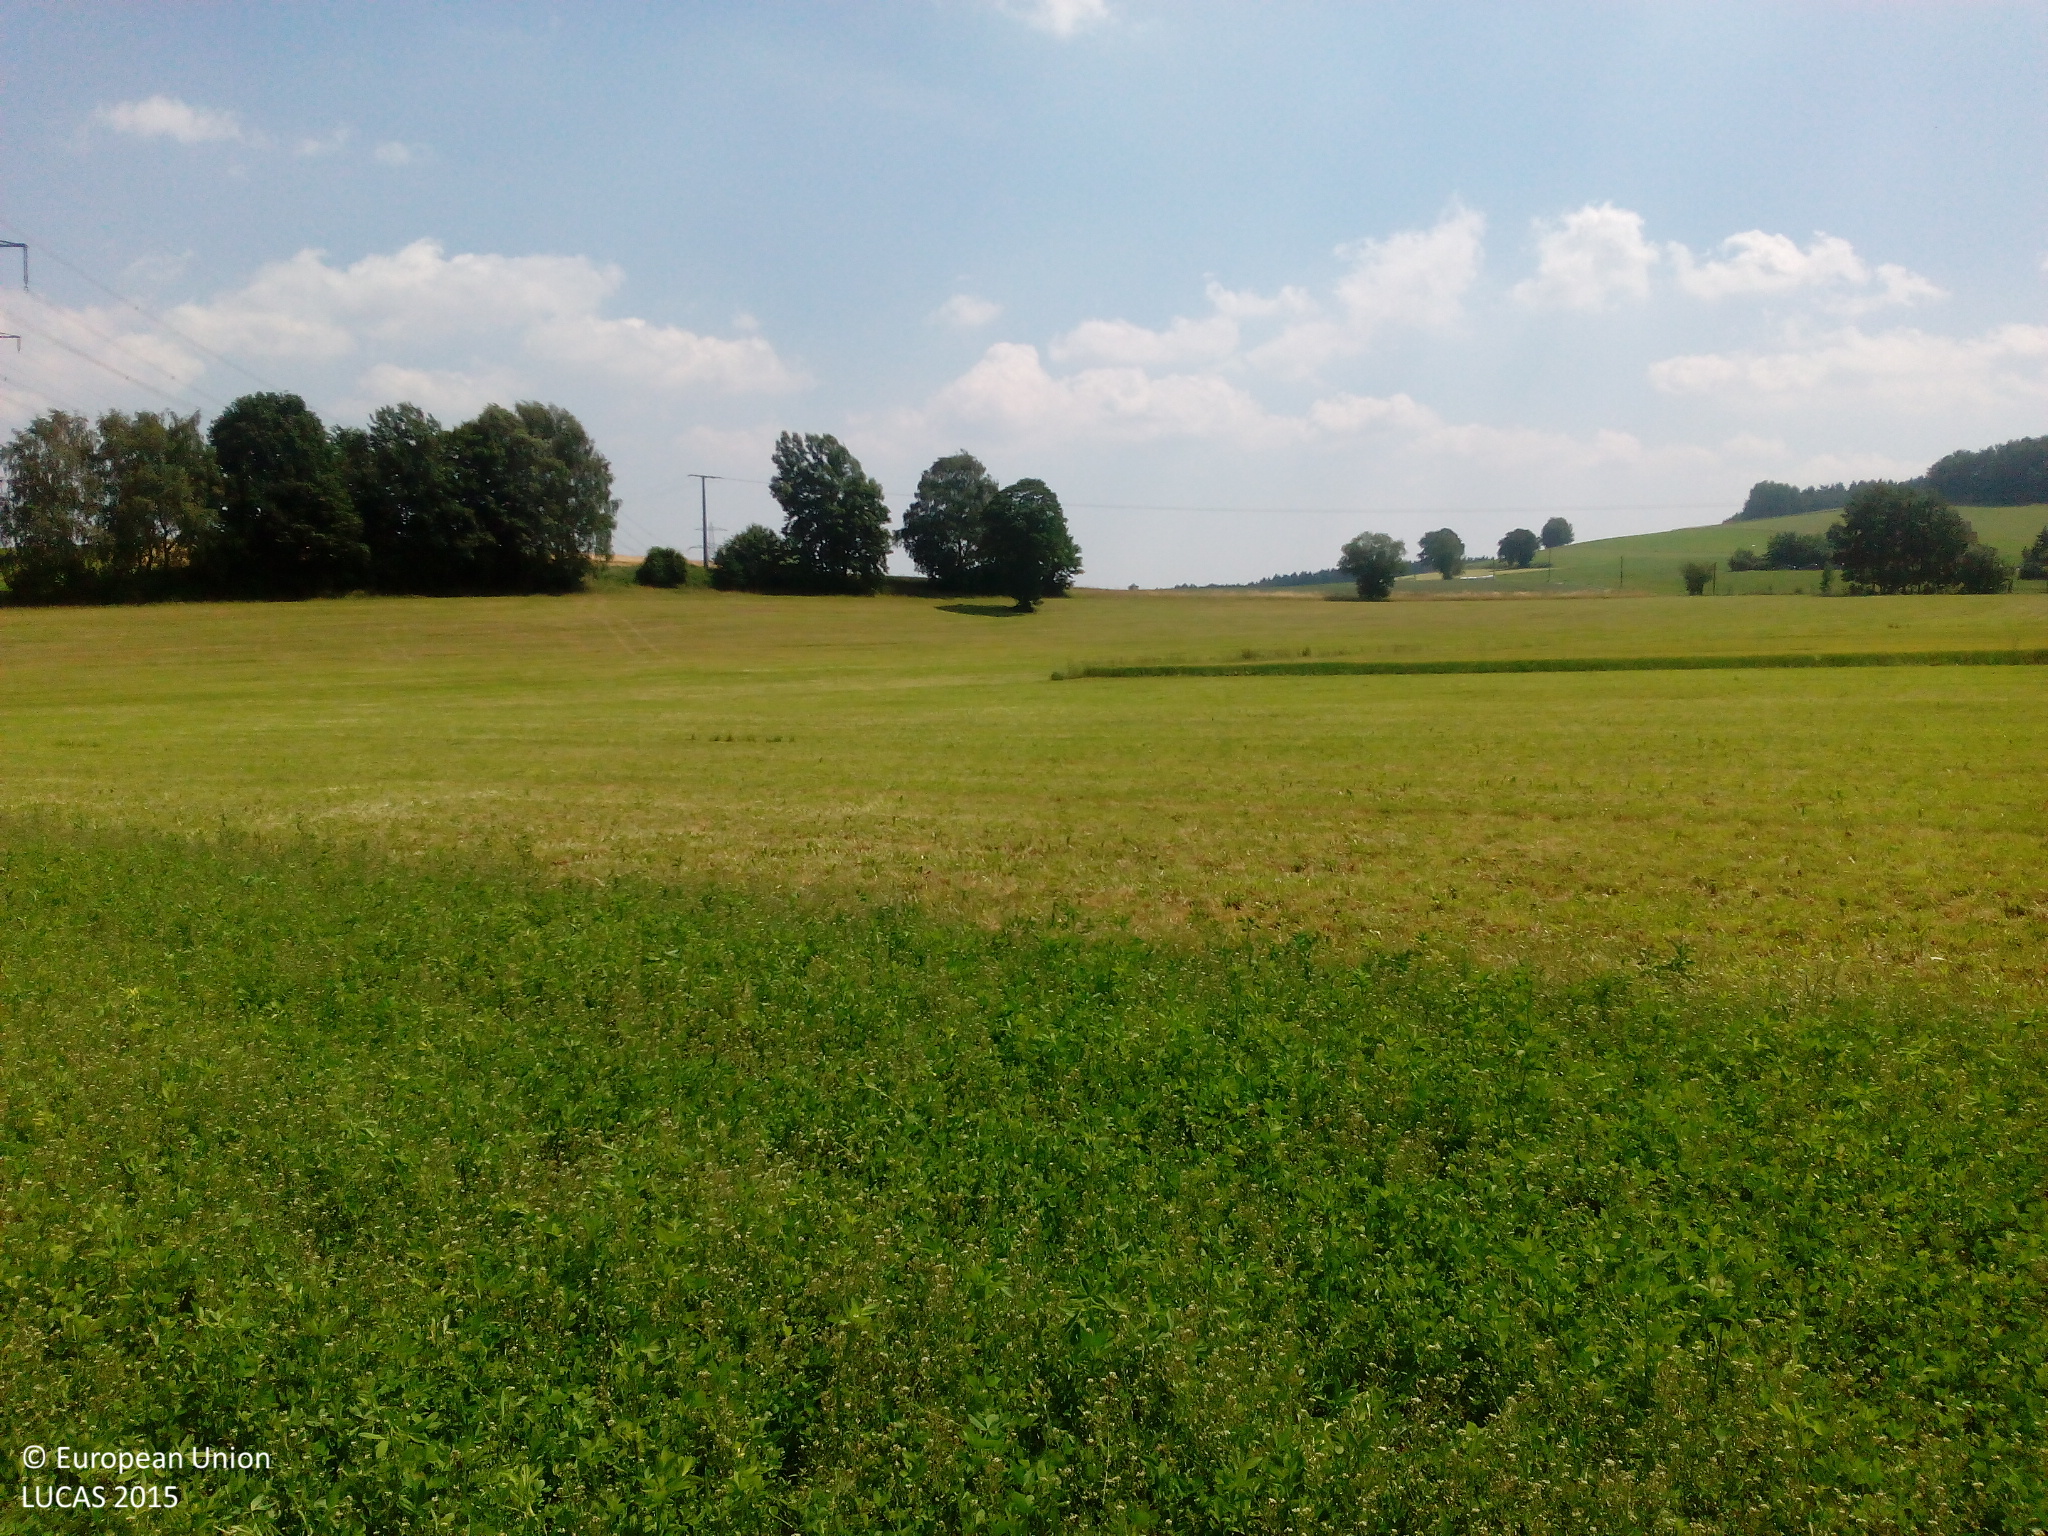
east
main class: Cropland
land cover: Other leguminous and mixtures for fodder
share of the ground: 50 - 75 %
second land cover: Lucerne
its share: 50 - 75 %
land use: Agriculture (excluding fallow land and kitchen gardens)
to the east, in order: Other leguminous and mixtures for fodder; Lucerne; Grassland without tree/shrub cover; Electric lines; Grassland without tree/shrub cover; Single bushes/trees; Grassland without tree/shrub cover; Tracks; Grass margins; Abandoned hedges; Grass margins; Common wheat
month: July
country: DE
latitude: 49.6002
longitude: 12.4486
